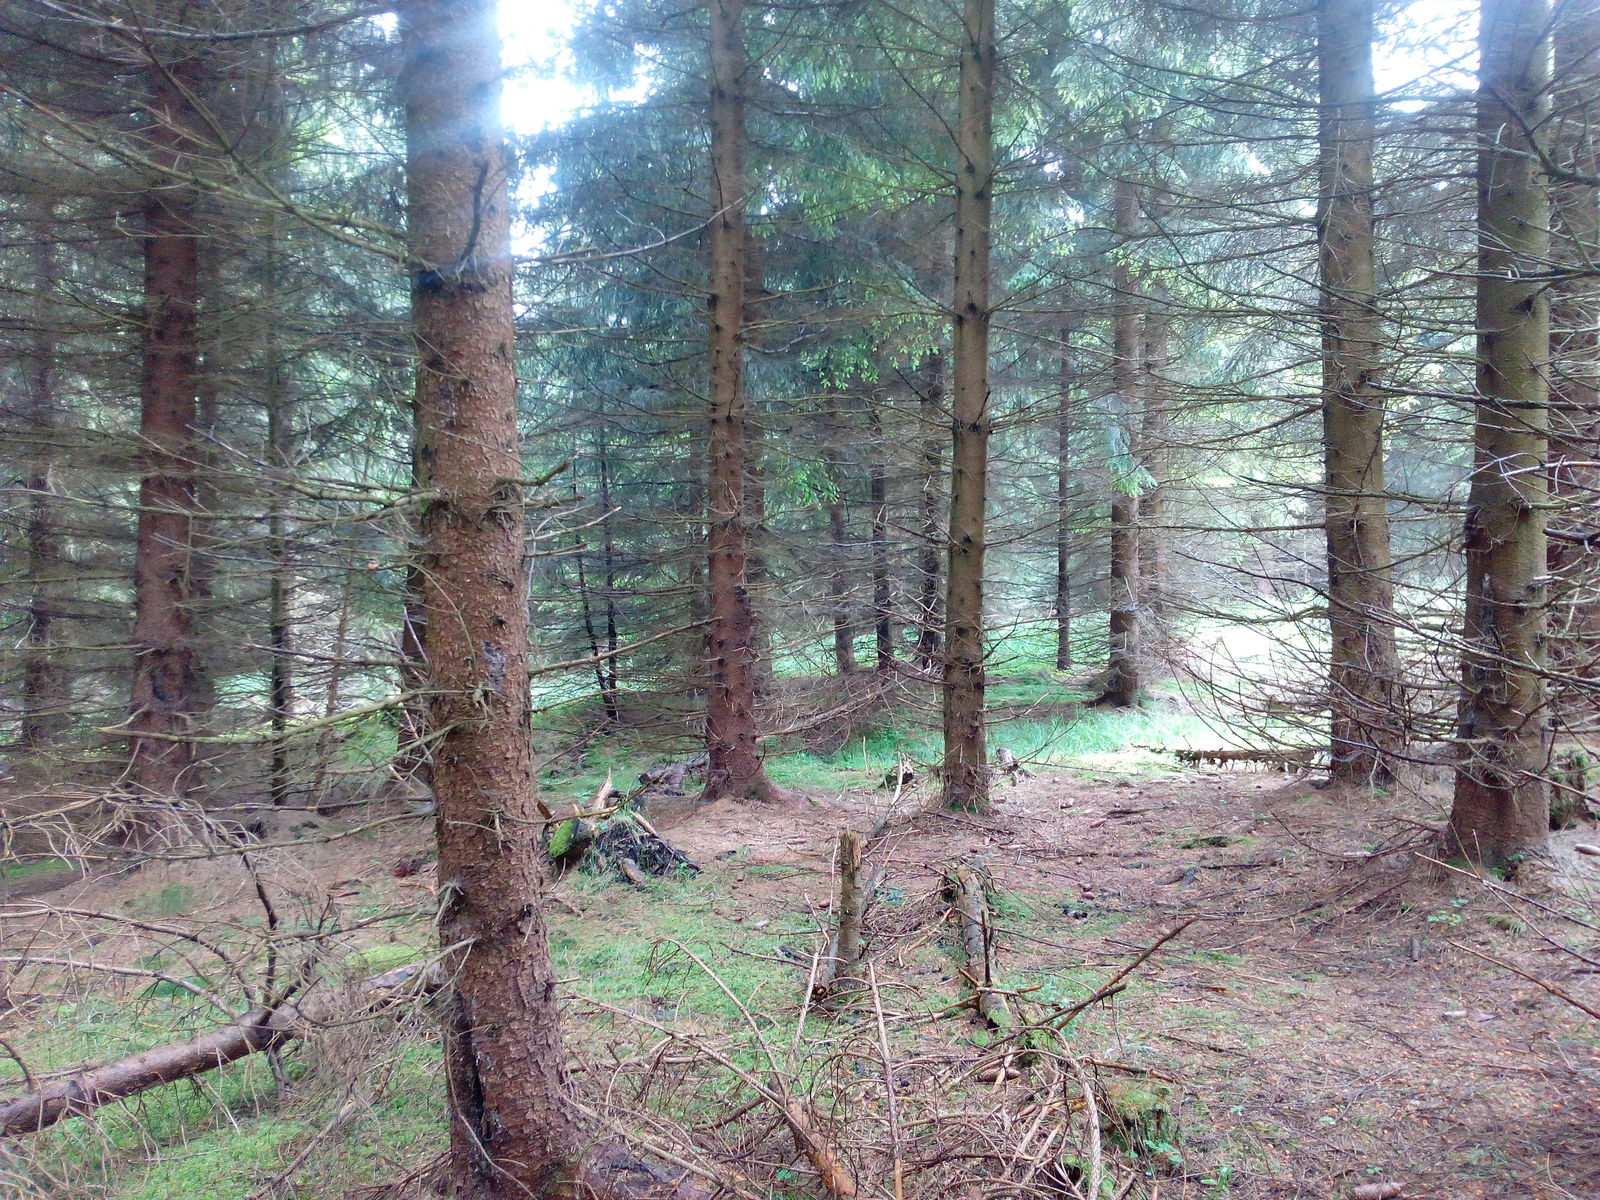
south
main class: Woodland
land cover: Spruce dominated coniferous woodland
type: hemiboreal forest and nemoral coniferous forest and mixed broadleaved-coniferous forest
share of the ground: 50 - 75 %
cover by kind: coniferous forest trees 70 %, herbaceous plants 30 %
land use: Forestry
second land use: Amenities, museums, leisure
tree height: > 5 m
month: June
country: DE
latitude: 50.5400
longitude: 10.9451
